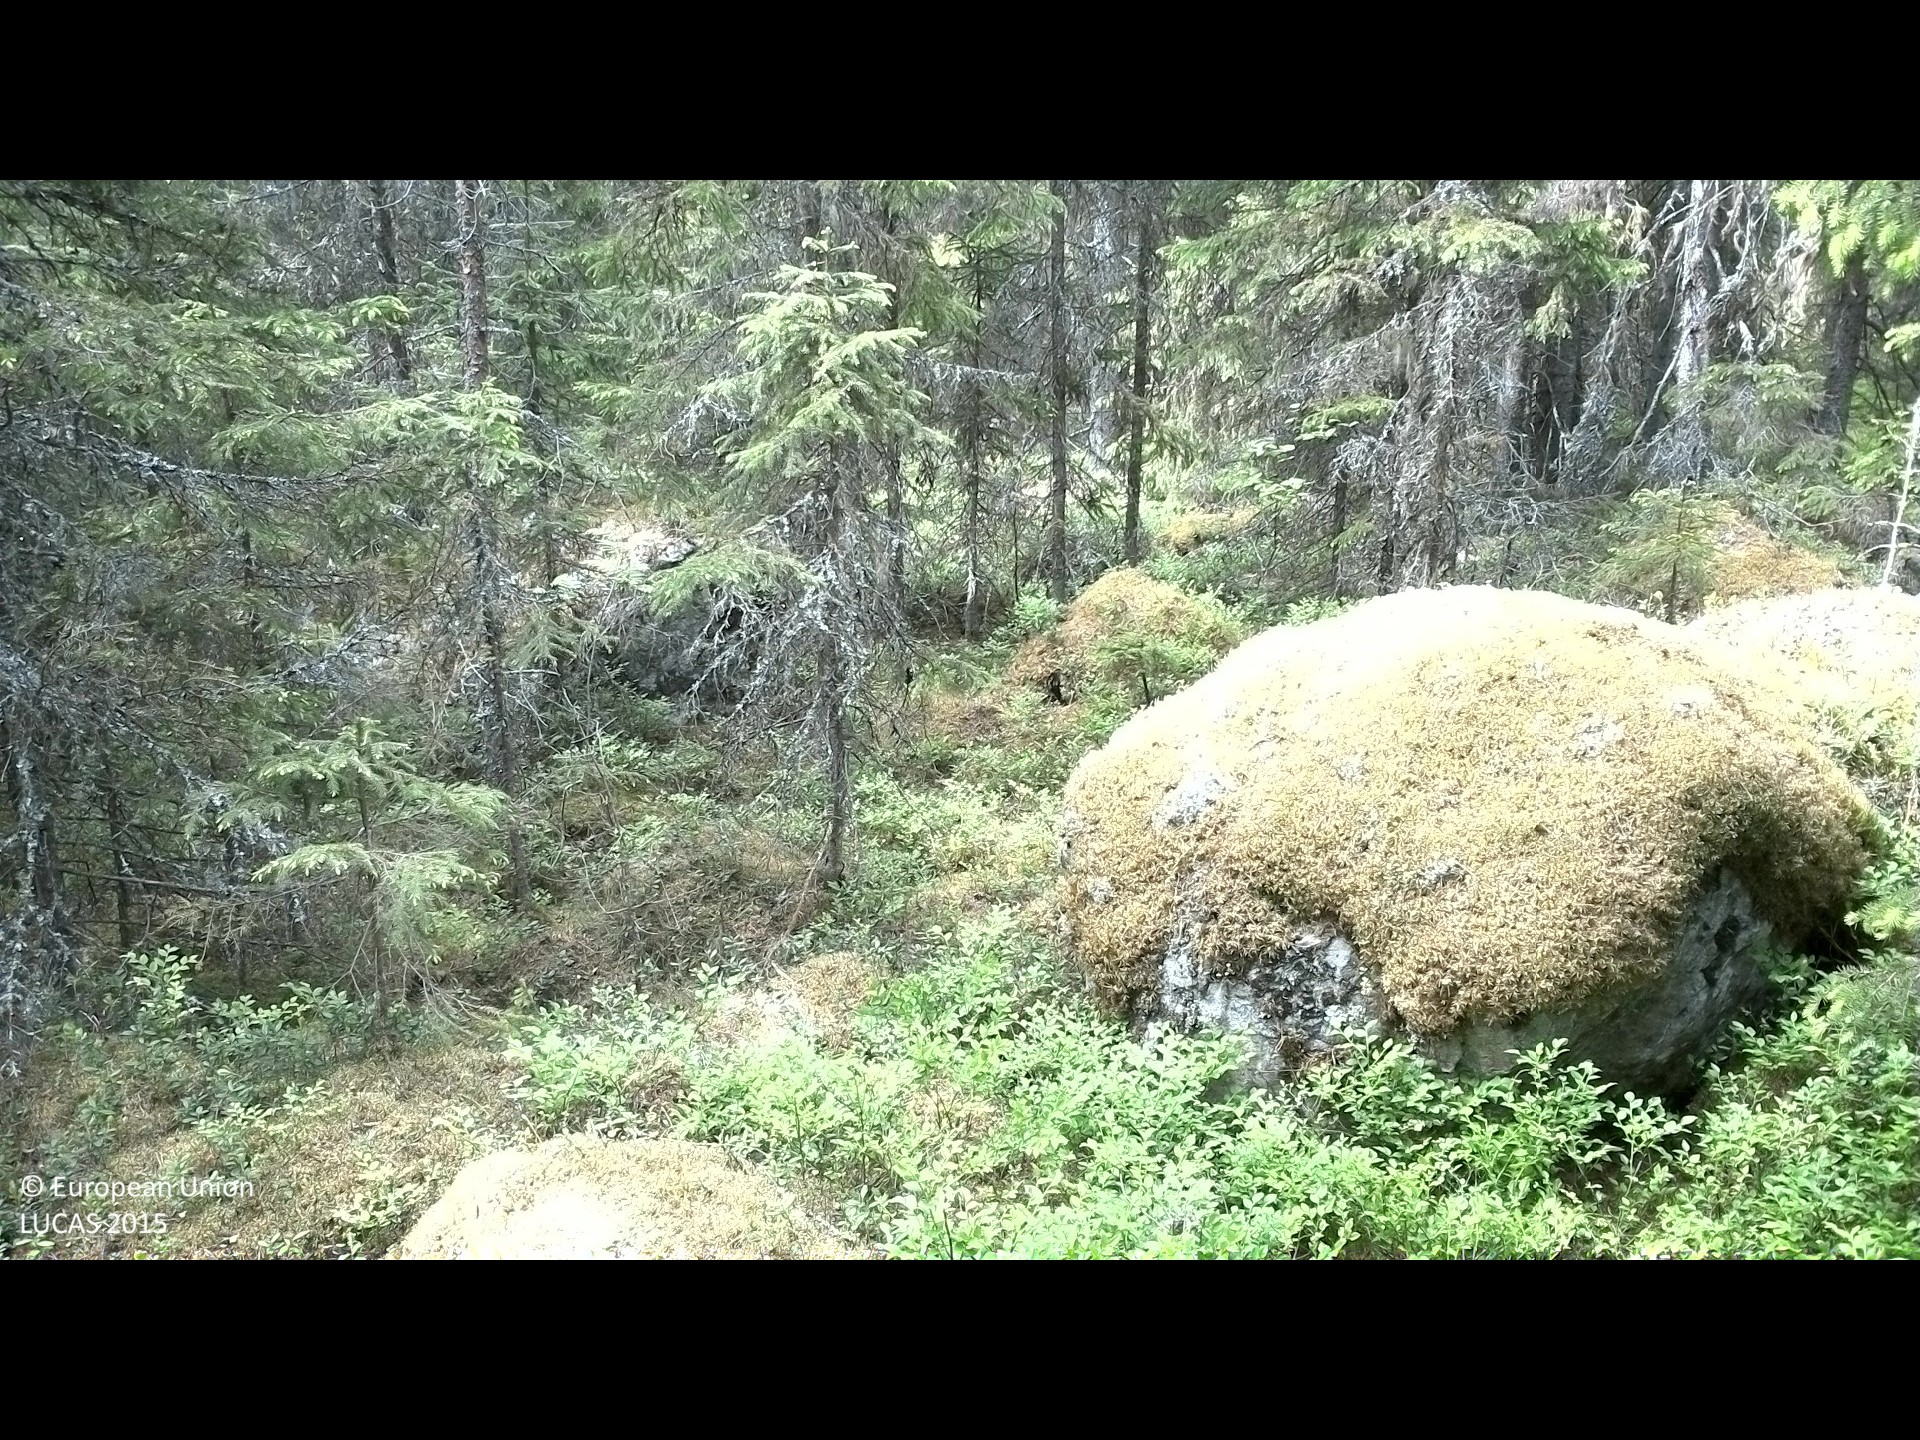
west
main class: Woodland
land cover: Spruce dominated coniferous woodland
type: boreal forest
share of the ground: 50 - 75 %
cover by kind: coniferous forest trees 60 %, lichens and mosses 20 %, shrubs 15 %, herbaceous plants 5 %
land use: Amenities, museums, leisure
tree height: > 5 m
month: June
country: SE
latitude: 62.2201
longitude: 17.6174
